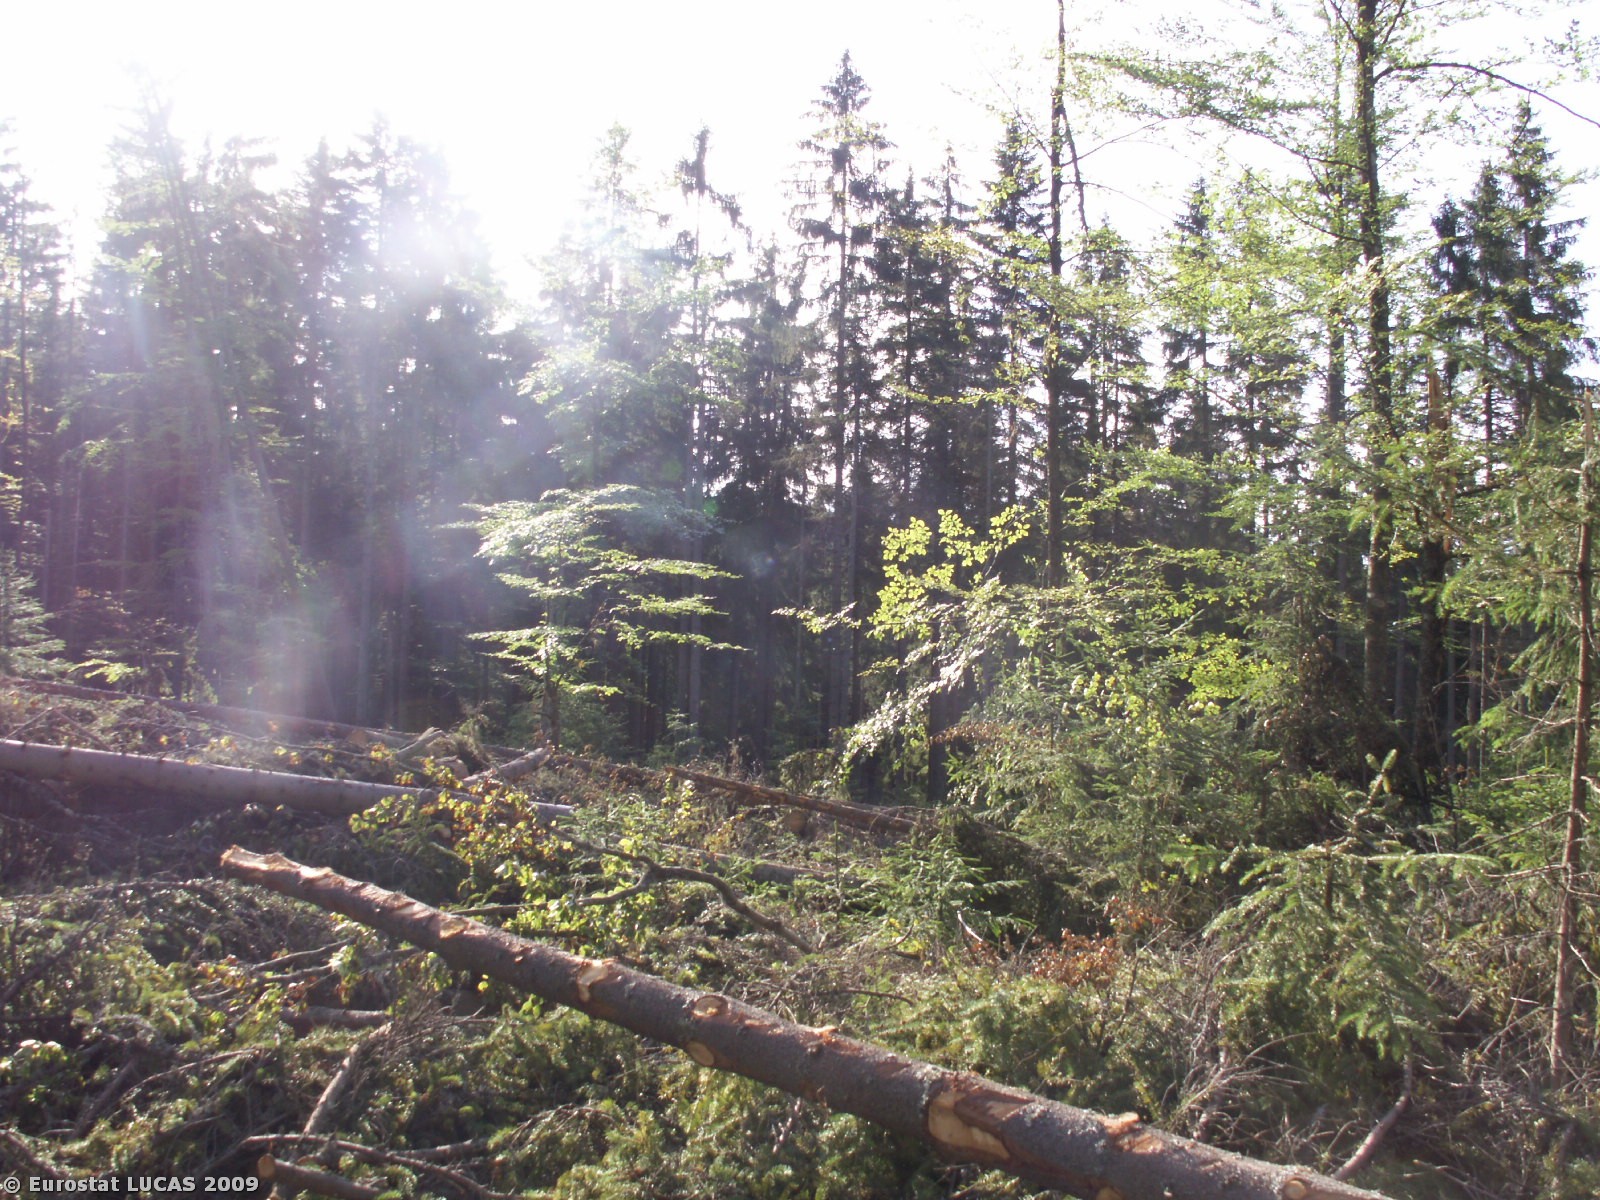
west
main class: Woodland
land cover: Coniferous woodland
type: hemiboreal forest and nemoral coniferous forest and mixed broadleaved-coniferous forest
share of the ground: > 75 %
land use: Forestry
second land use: Nature reserves
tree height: > 5 m
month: July
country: CZ
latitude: 48.8056
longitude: 13.8261
